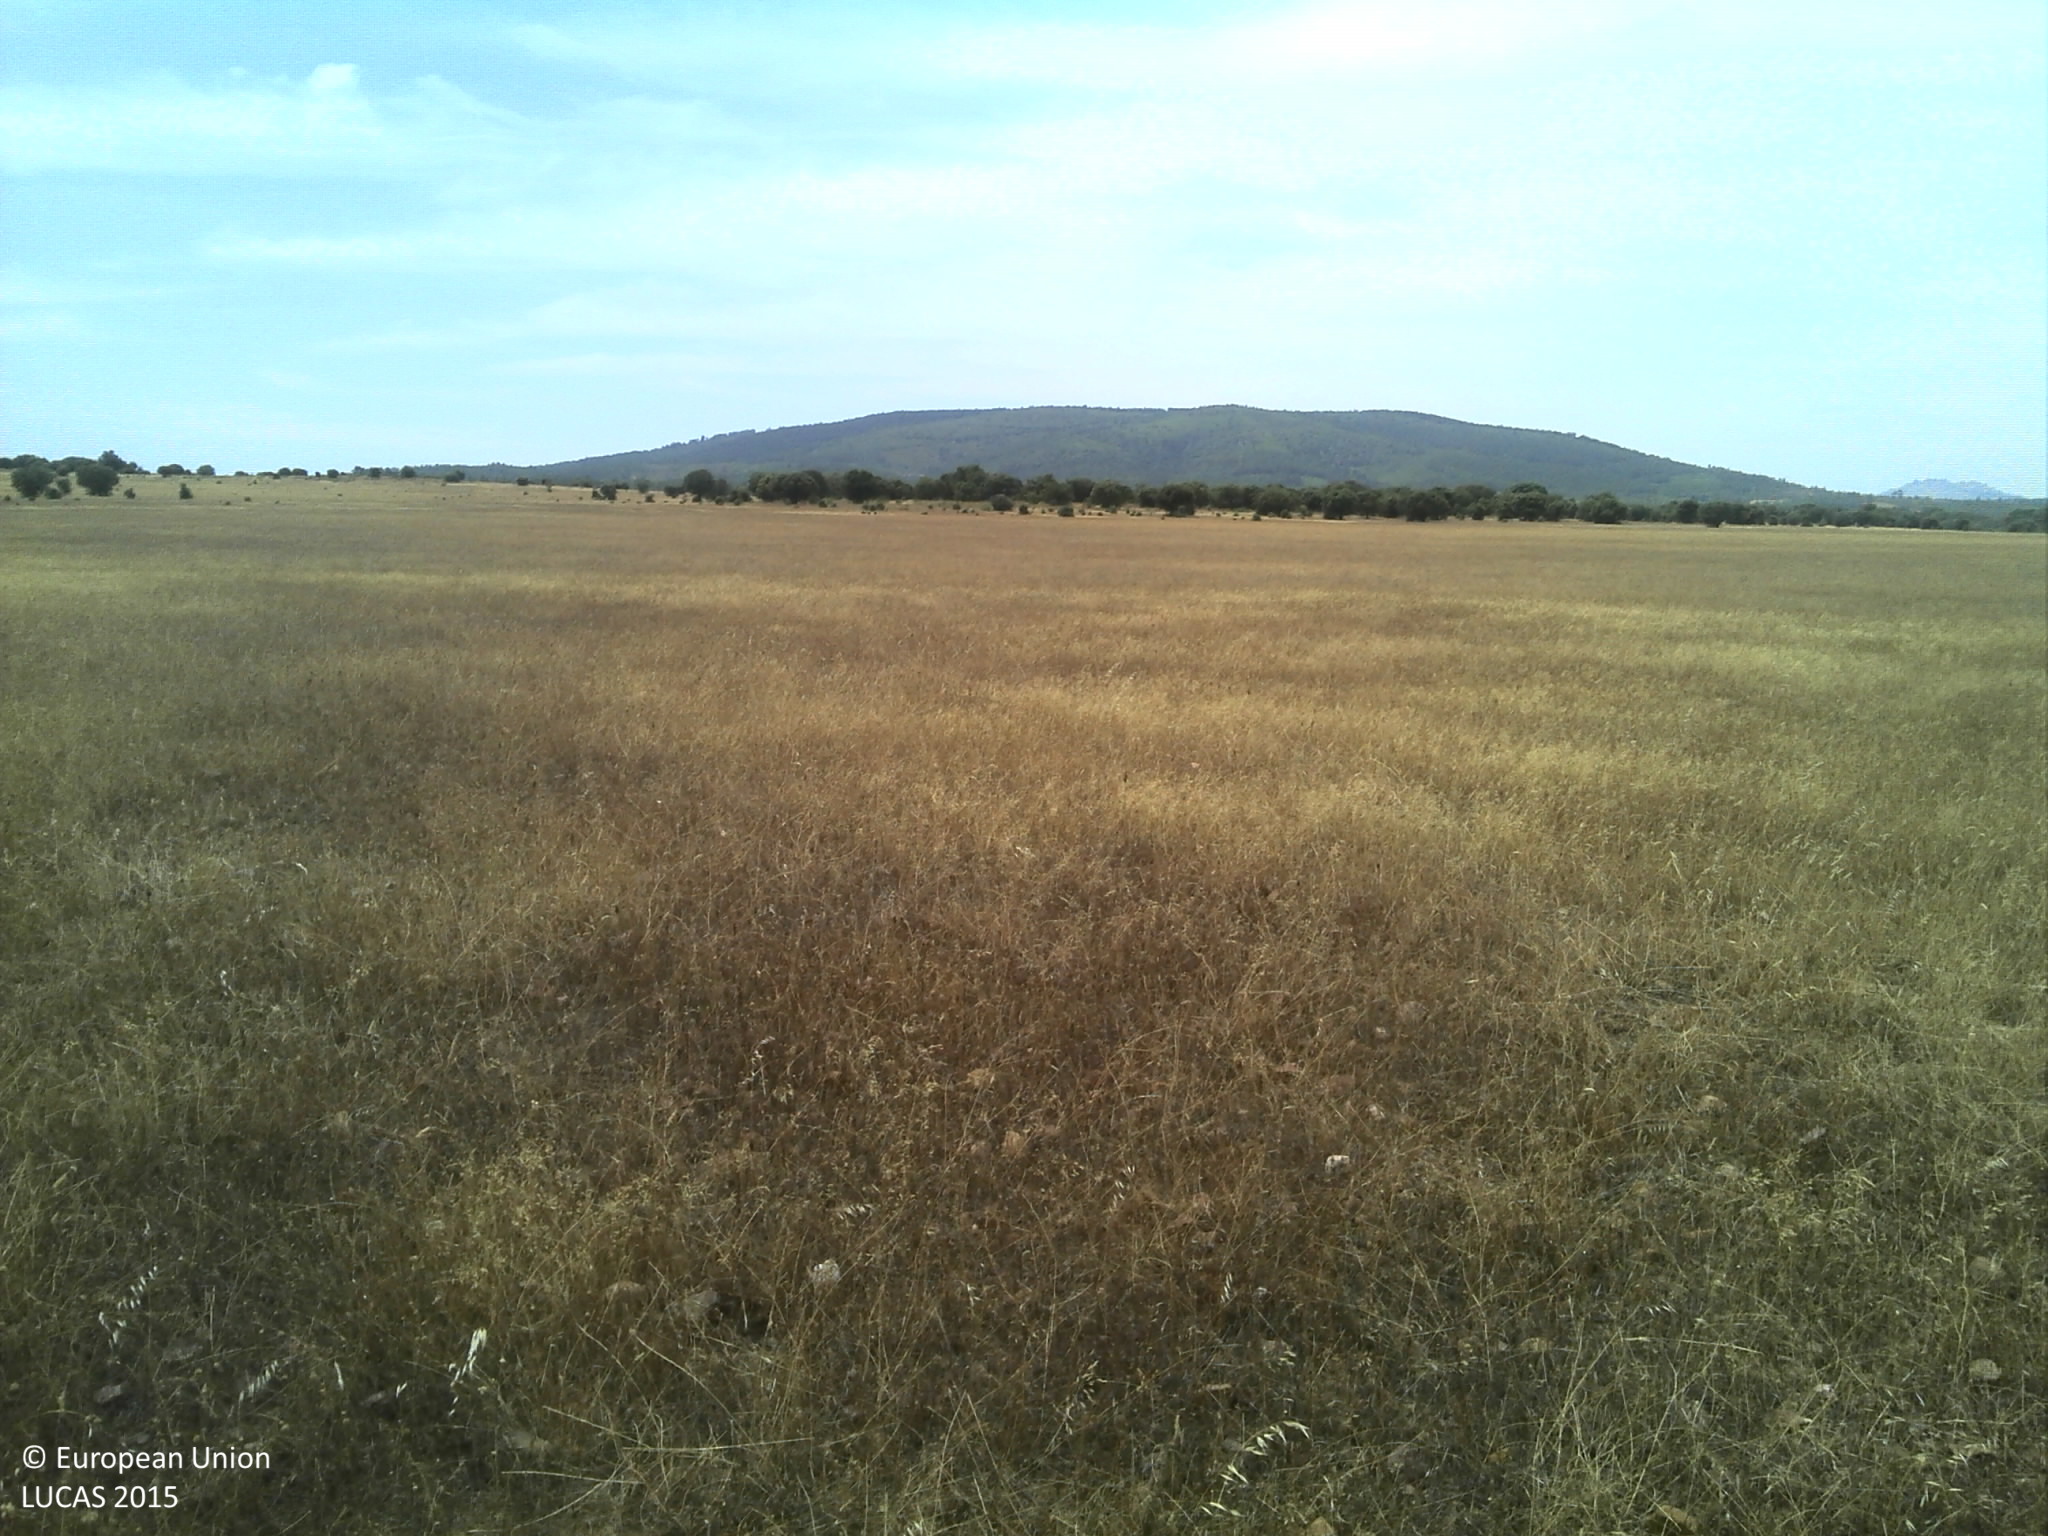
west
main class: Grassland
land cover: Grassland without tree/shrub cover
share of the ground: 25 - 50 %
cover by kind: unconsolidated bare surface 65 %, herbaceous plants 35 %
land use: Agriculture (excluding fallow land and kitchen gardens)
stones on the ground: 10 - 25 %
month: June
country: PT
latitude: 39.9550
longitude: -6.9804
